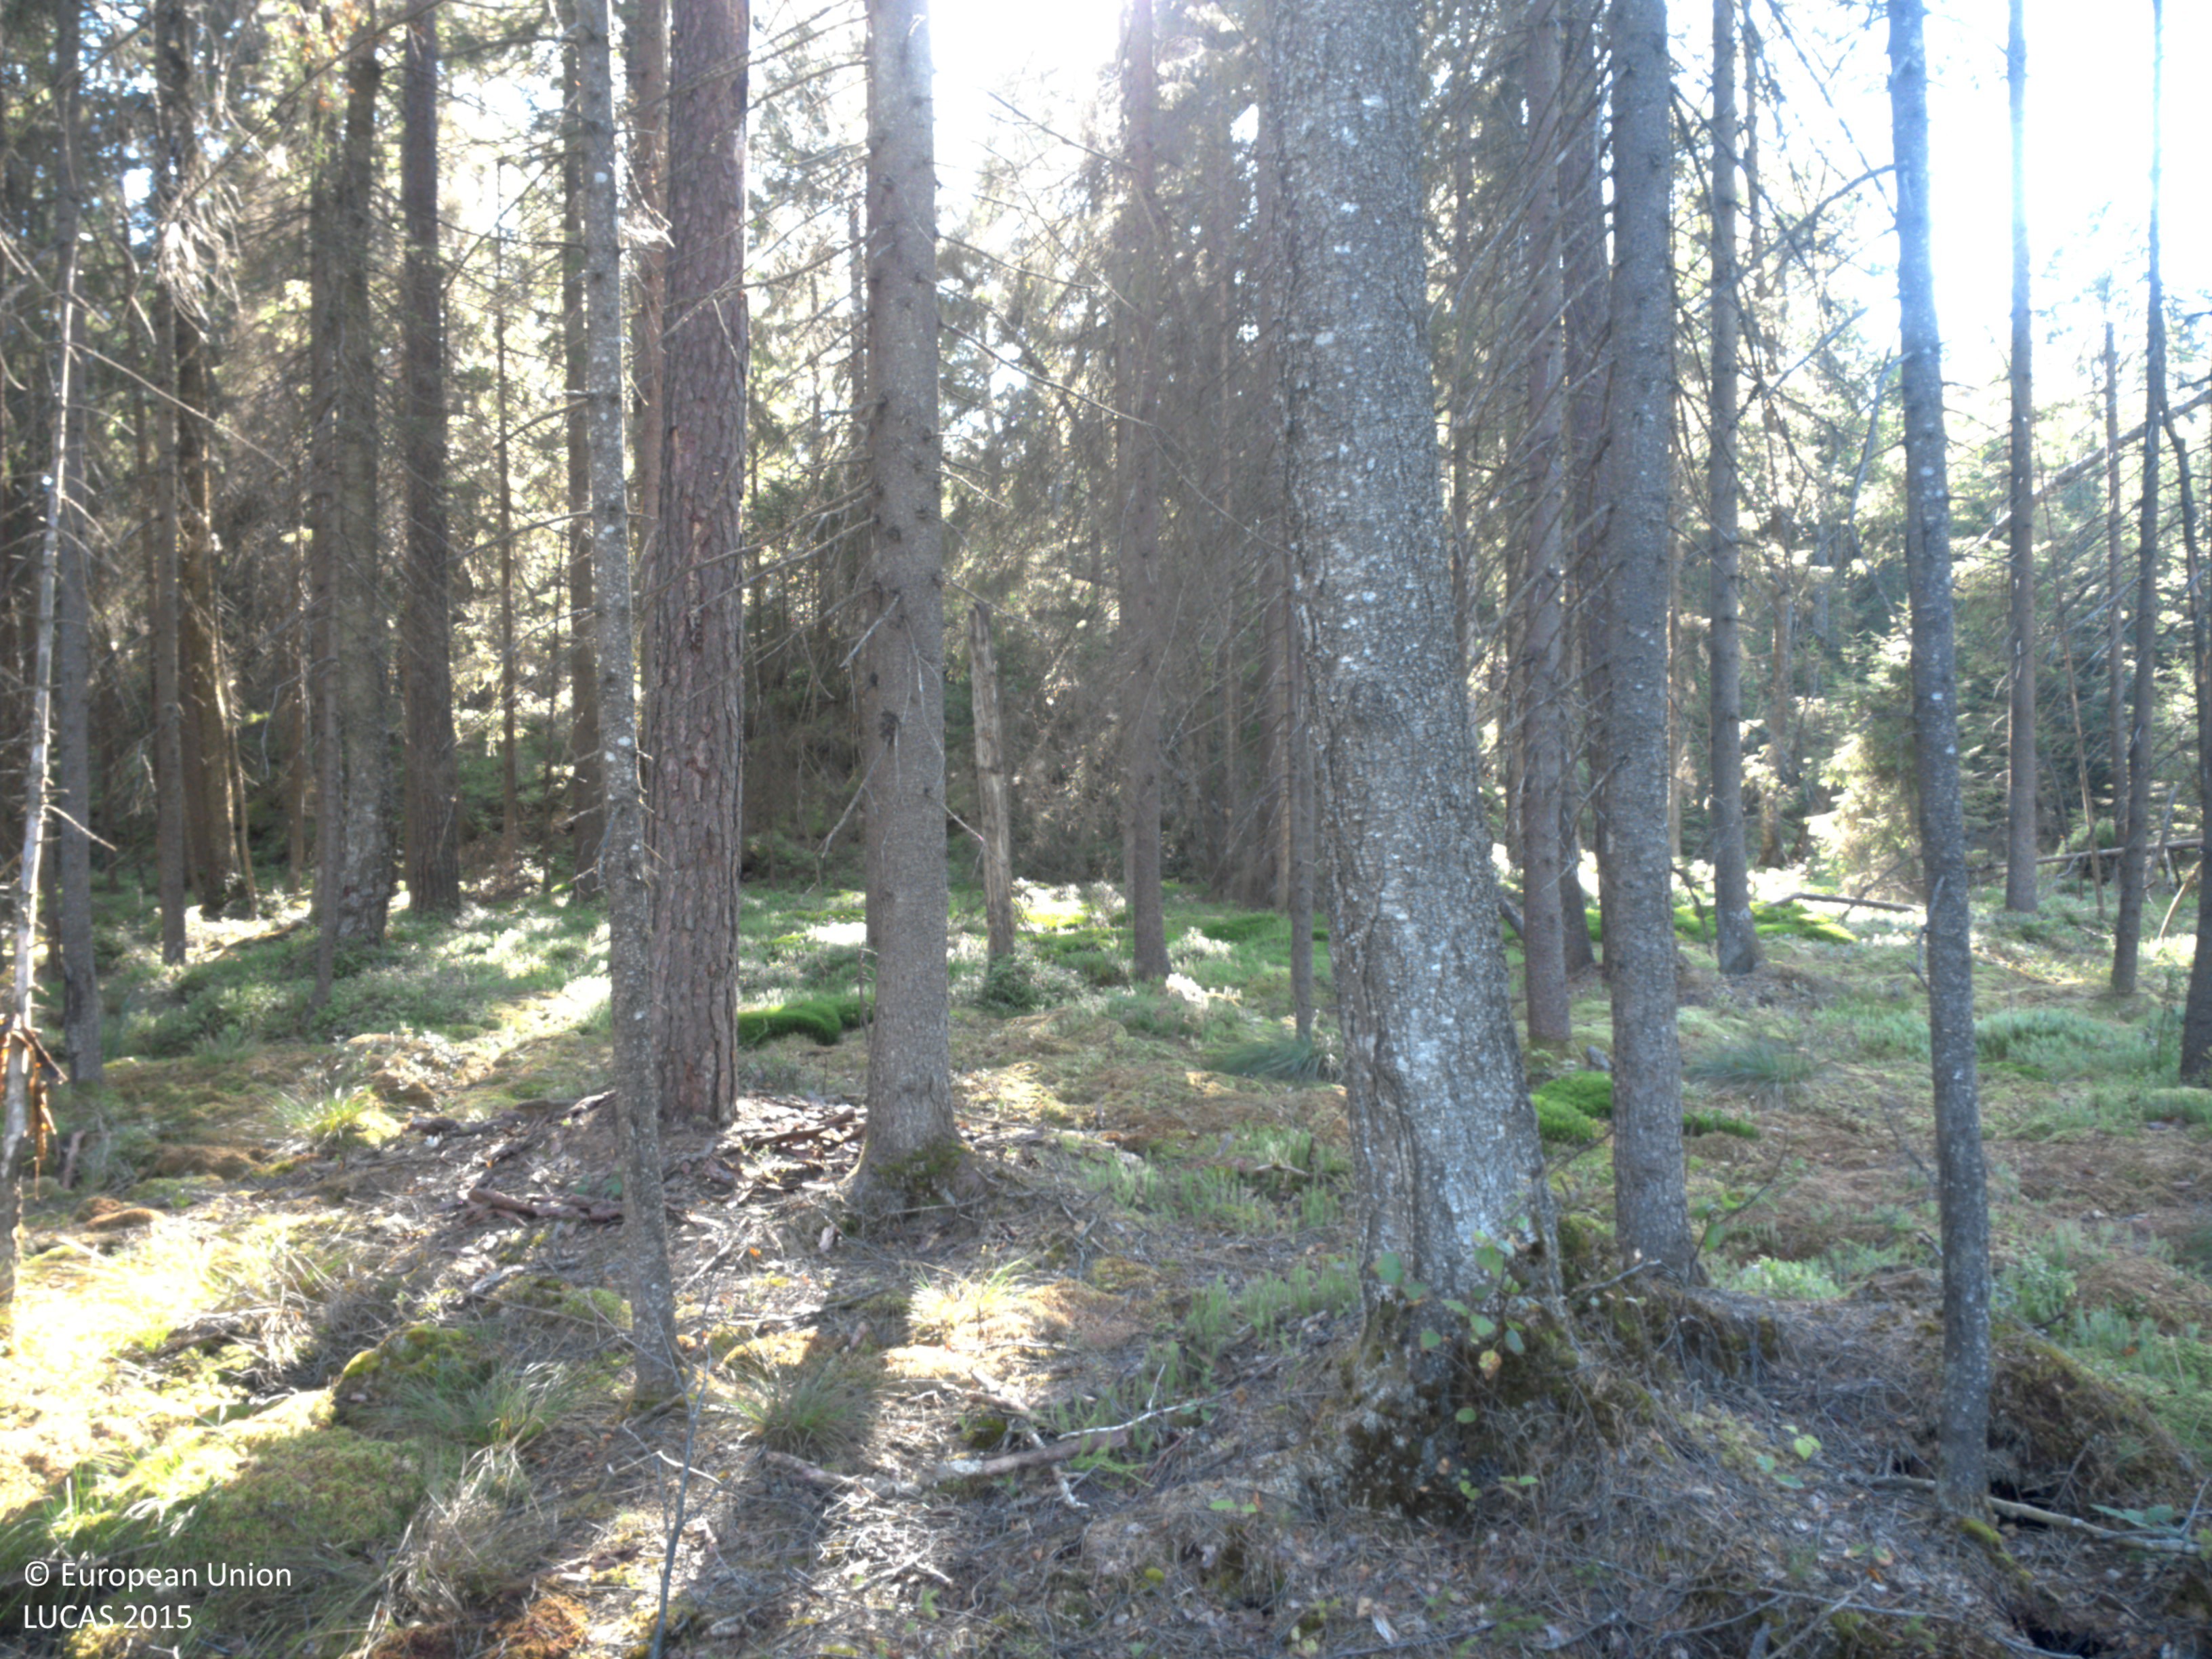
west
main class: Woodland
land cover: Spruce dominated coniferous woodland
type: boreal forest
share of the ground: 50 - 75 %
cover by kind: coniferous forest trees 60 %, lichens and mosses 25 %, herbaceous plants 10 %, broadleaved forest trees 5 %
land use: Forestry
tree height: > 5 m
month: August
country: SE
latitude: 58.5453
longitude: 12.0746
